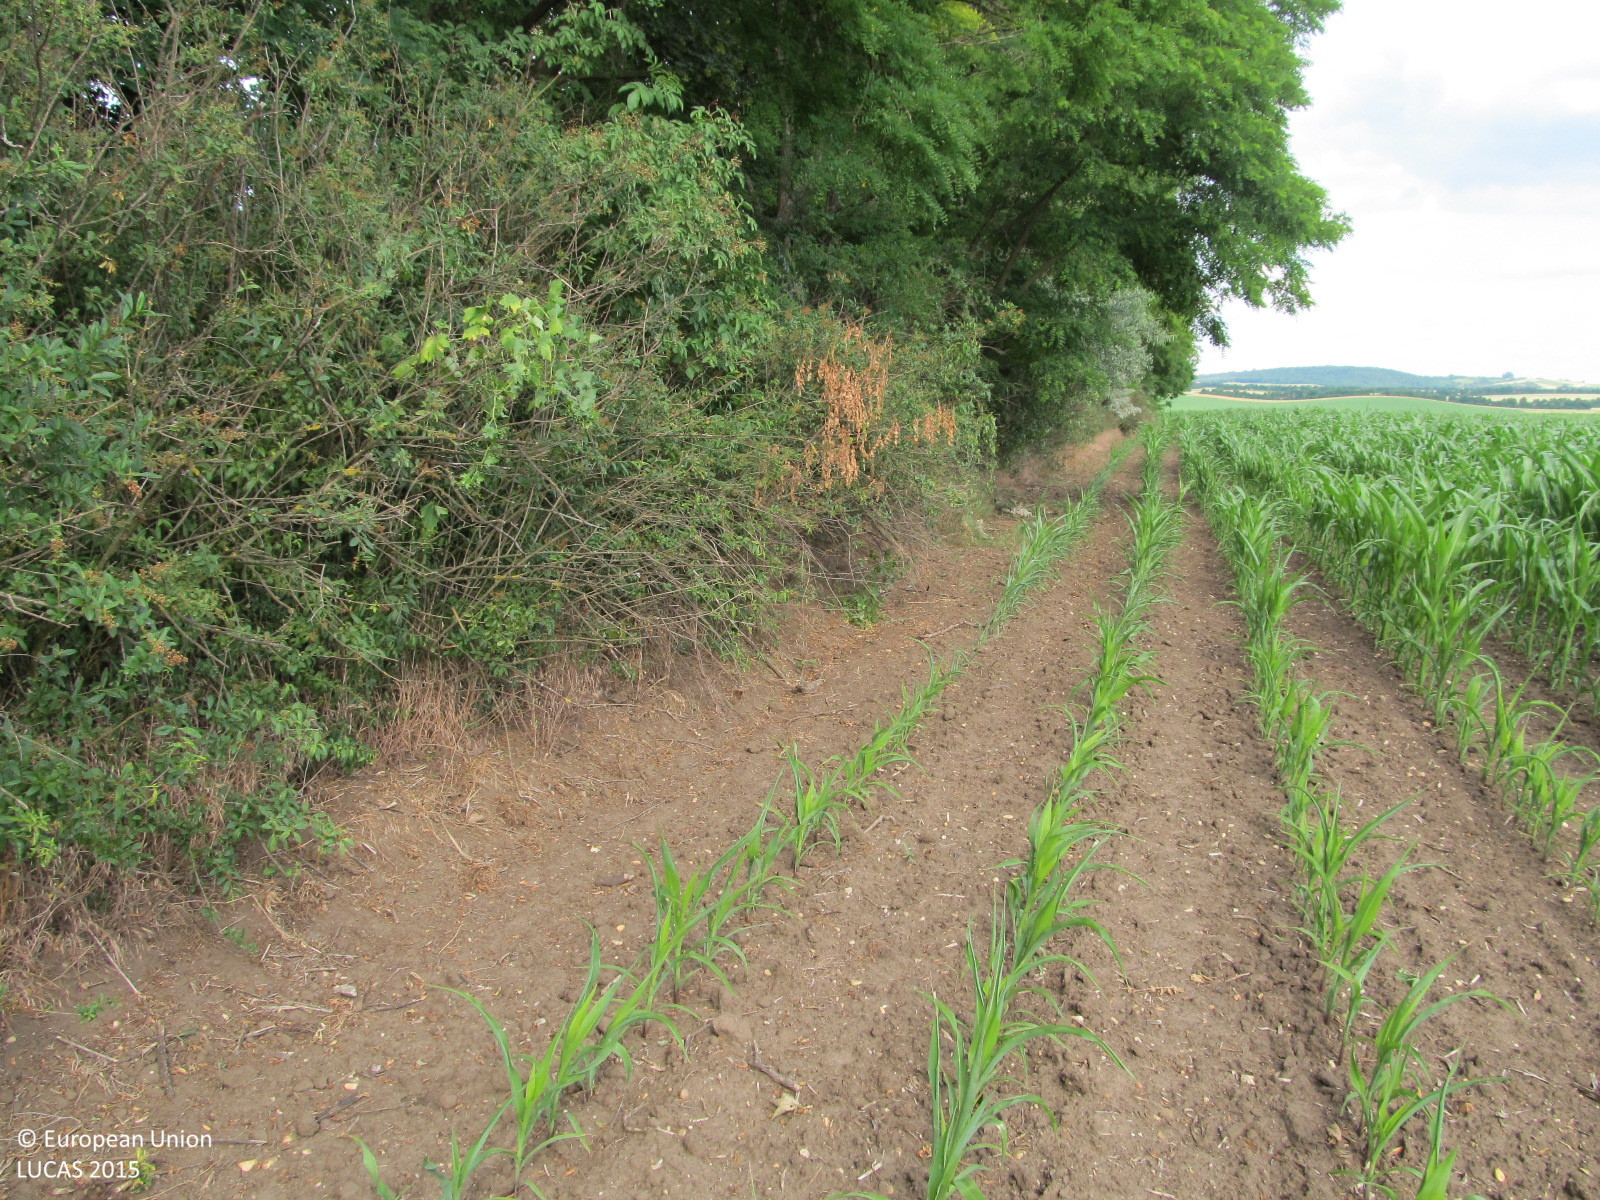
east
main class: Cropland
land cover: Maize
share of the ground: 50 - 75 %
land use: Agriculture (excluding fallow land and kitchen gardens)
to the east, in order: Maize; Broadleaved woodland; Fences; Broadleaved woodland; Maize
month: June
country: AT
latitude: 48.6128
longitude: 16.1221
